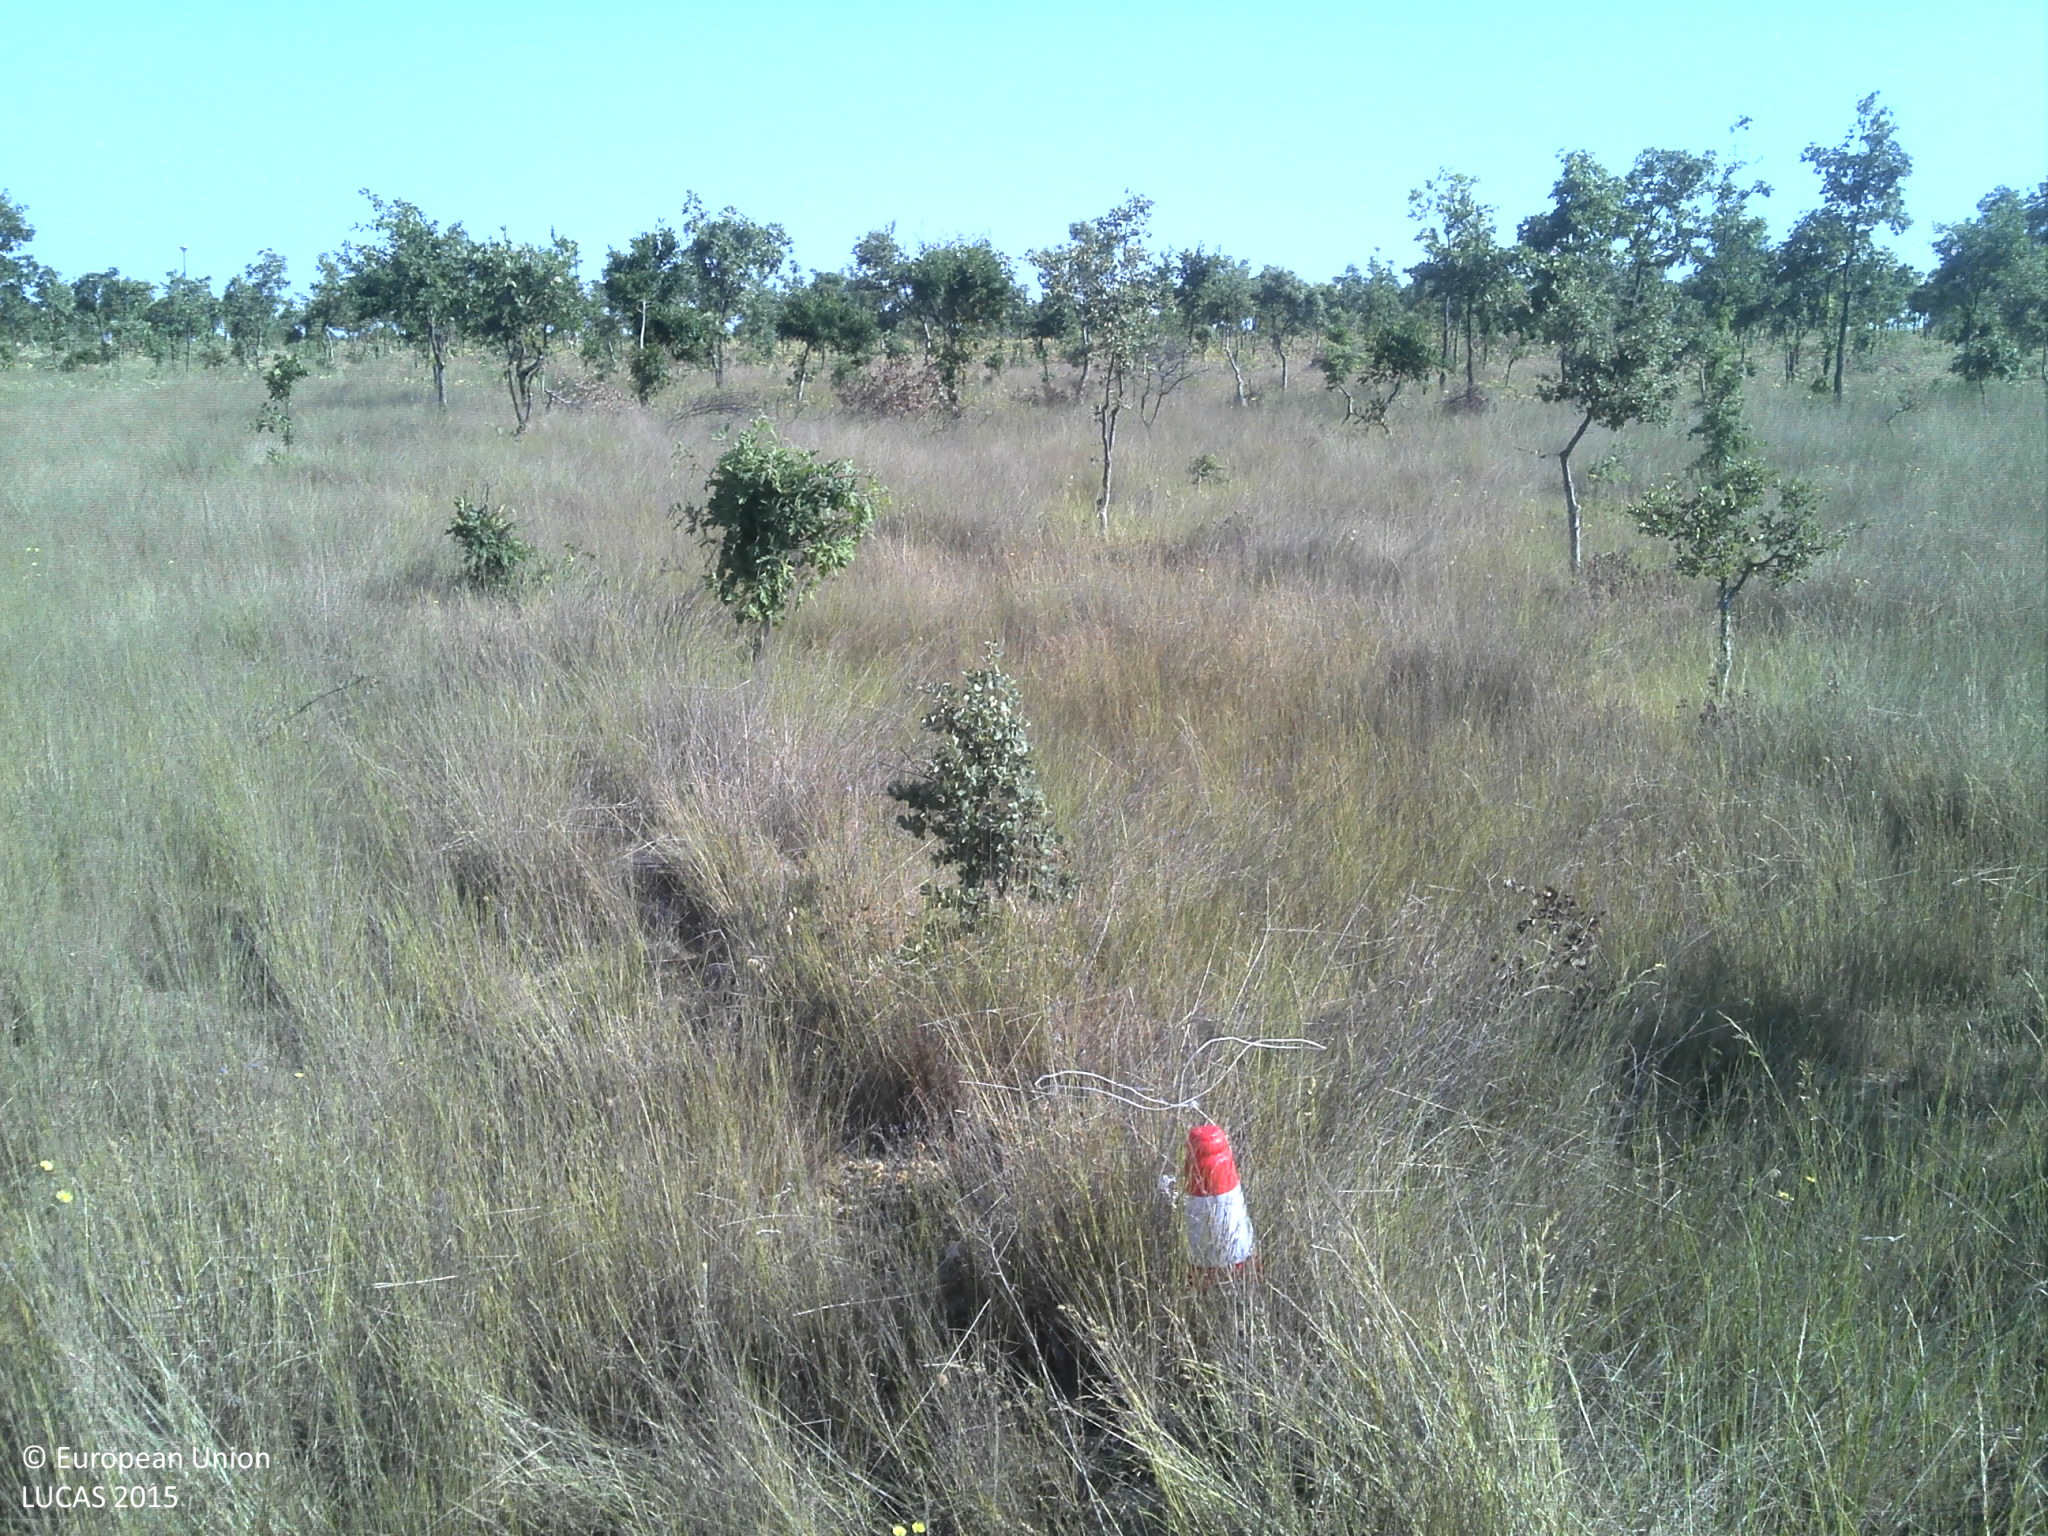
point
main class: Woodland
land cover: Broadleaved woodland
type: acidophilous oak and oak-birch forest
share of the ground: 10 - 25 %
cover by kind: herbaceous plants 60 %, broadleaved forest trees 25 %, unconsolidated bare surface 15 %
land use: Forestry
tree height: < 5 m
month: June
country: PT
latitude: 40.5878
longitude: -6.8386
